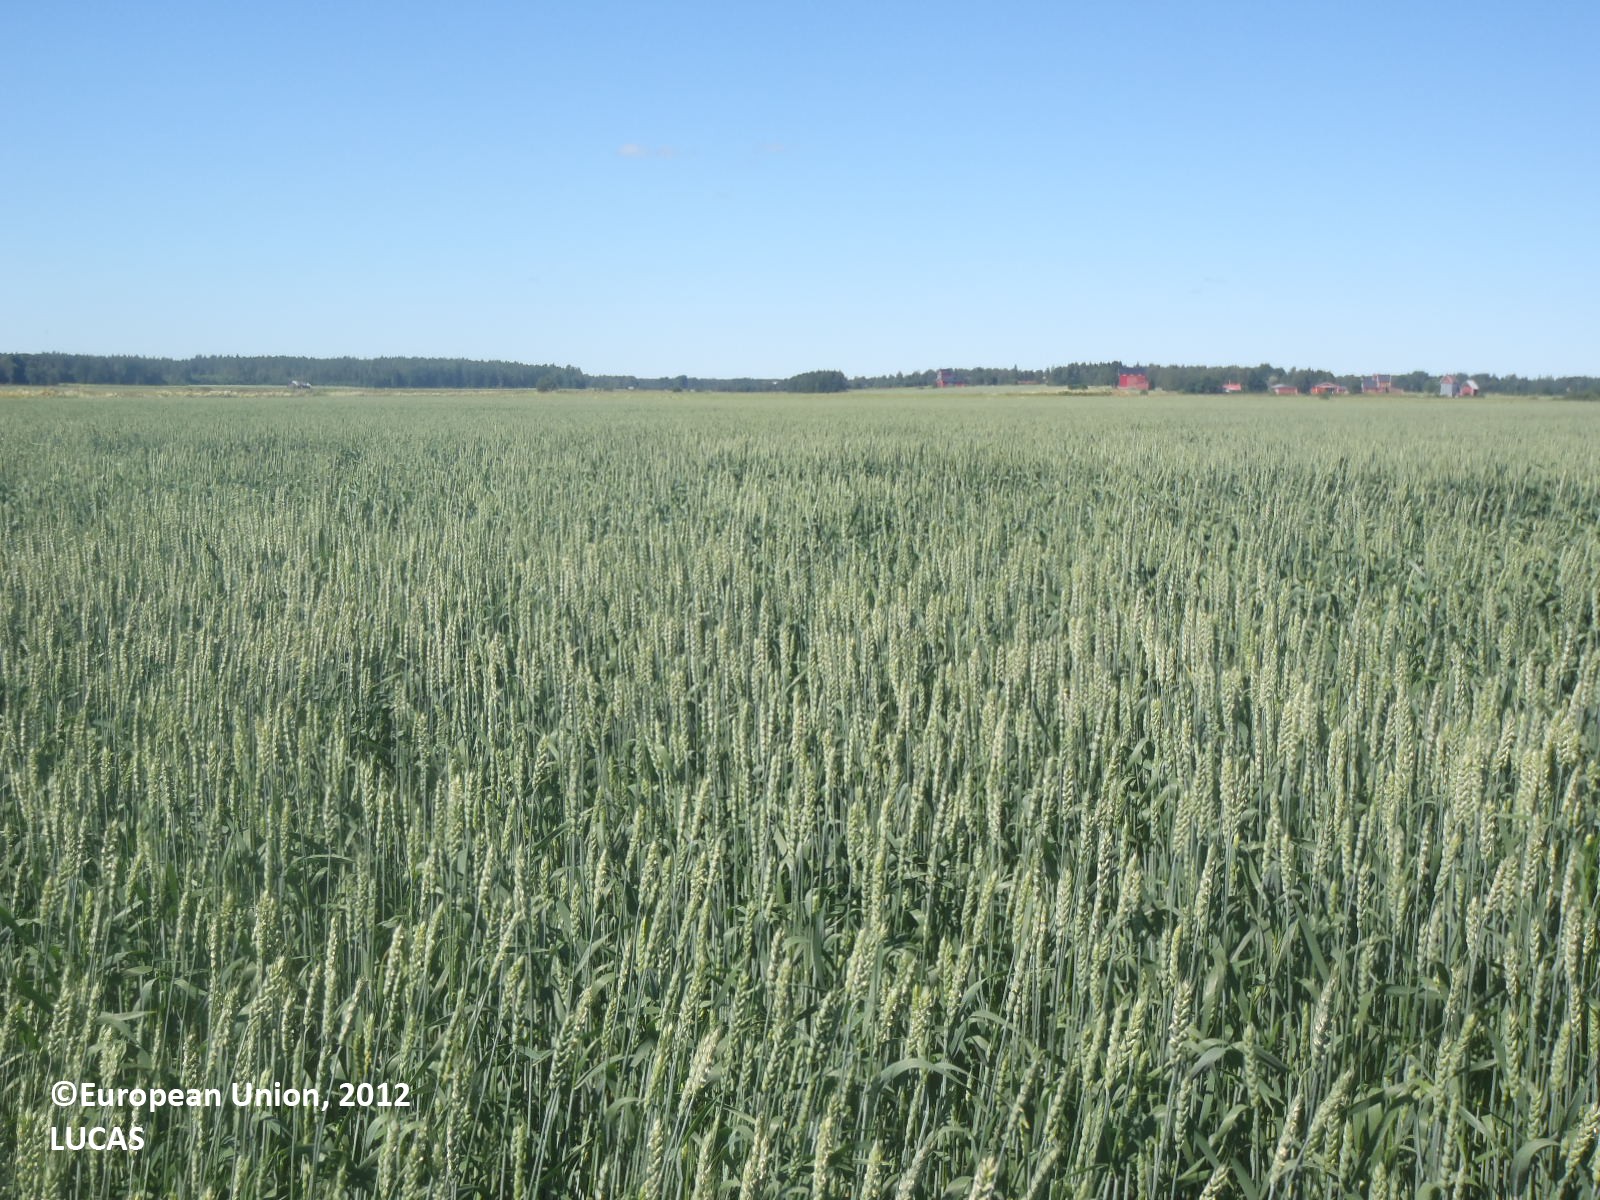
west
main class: Cropland
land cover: Common wheat
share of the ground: > 75 %
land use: Agriculture (excluding fallow land and kitchen gardens)
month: July
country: FI
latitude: 61.0347
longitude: 21.9993
